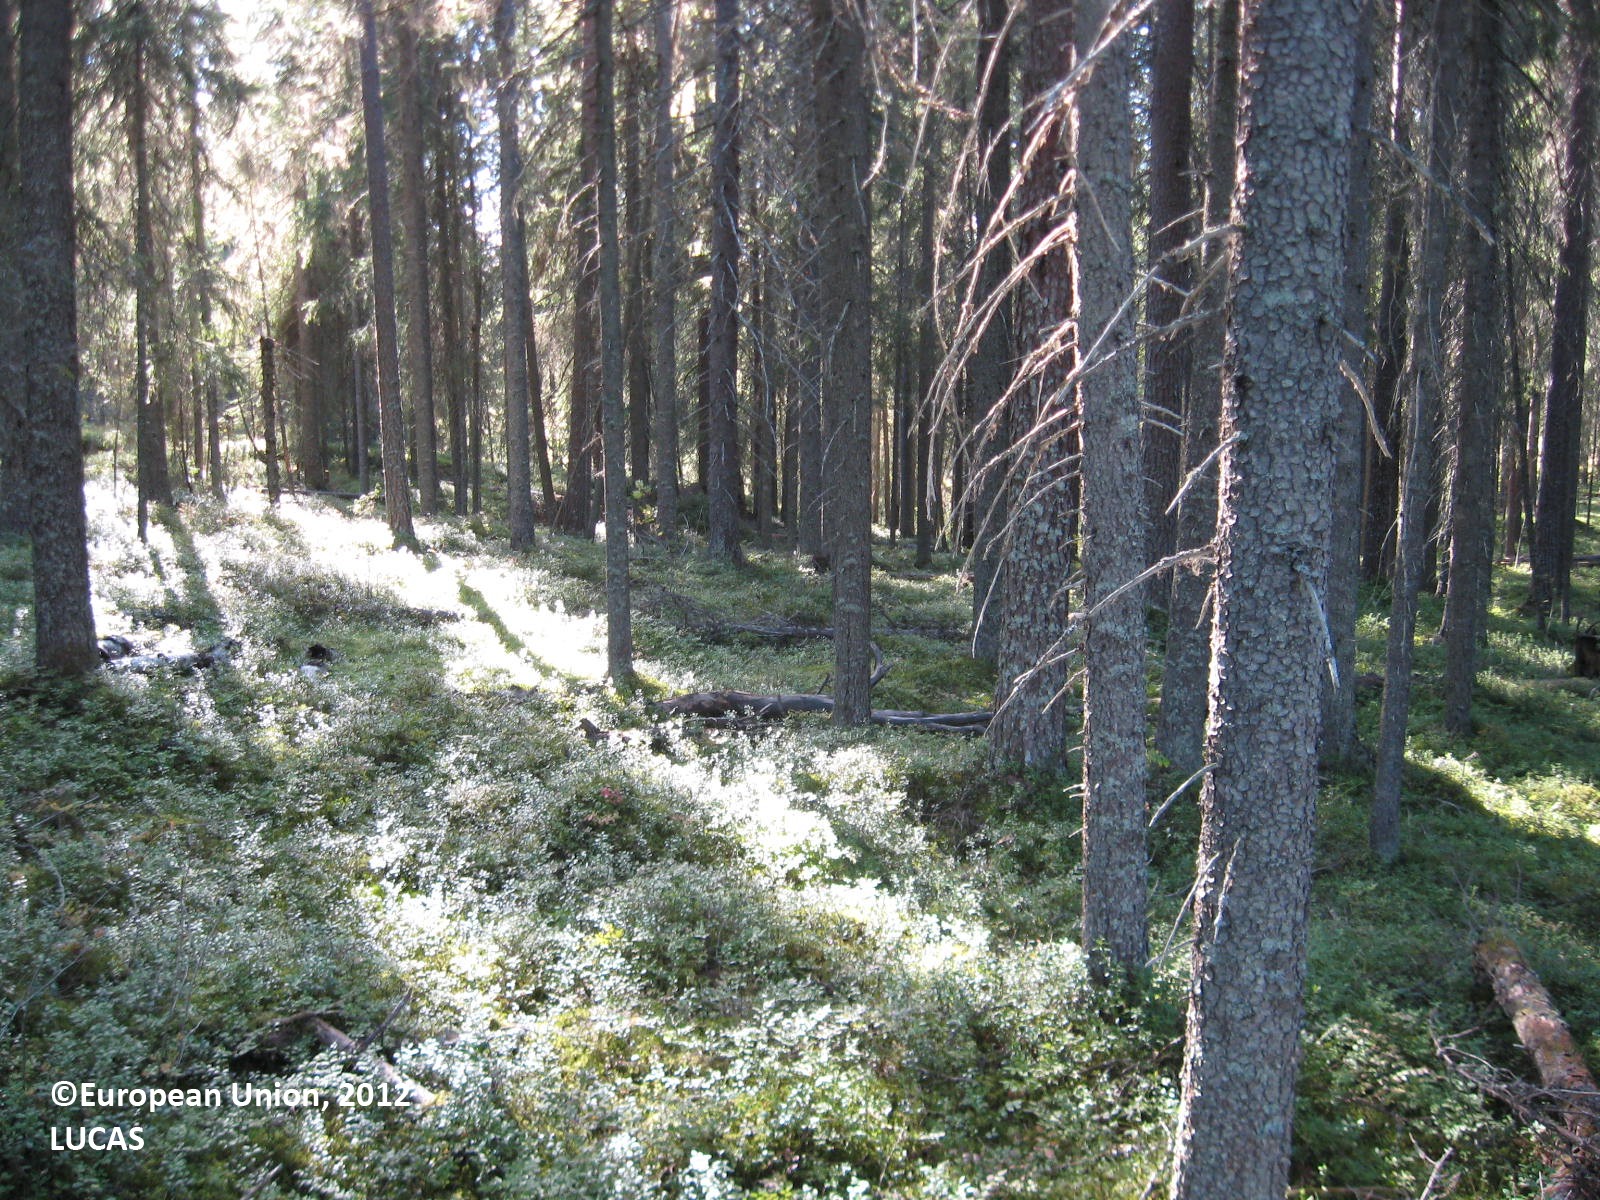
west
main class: Woodland
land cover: Spruce dominated coniferous woodland
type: boreal forest
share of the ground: > 75 %
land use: Forestry
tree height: > 5 m
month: August
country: FI
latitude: 63.8606
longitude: 30.0825
